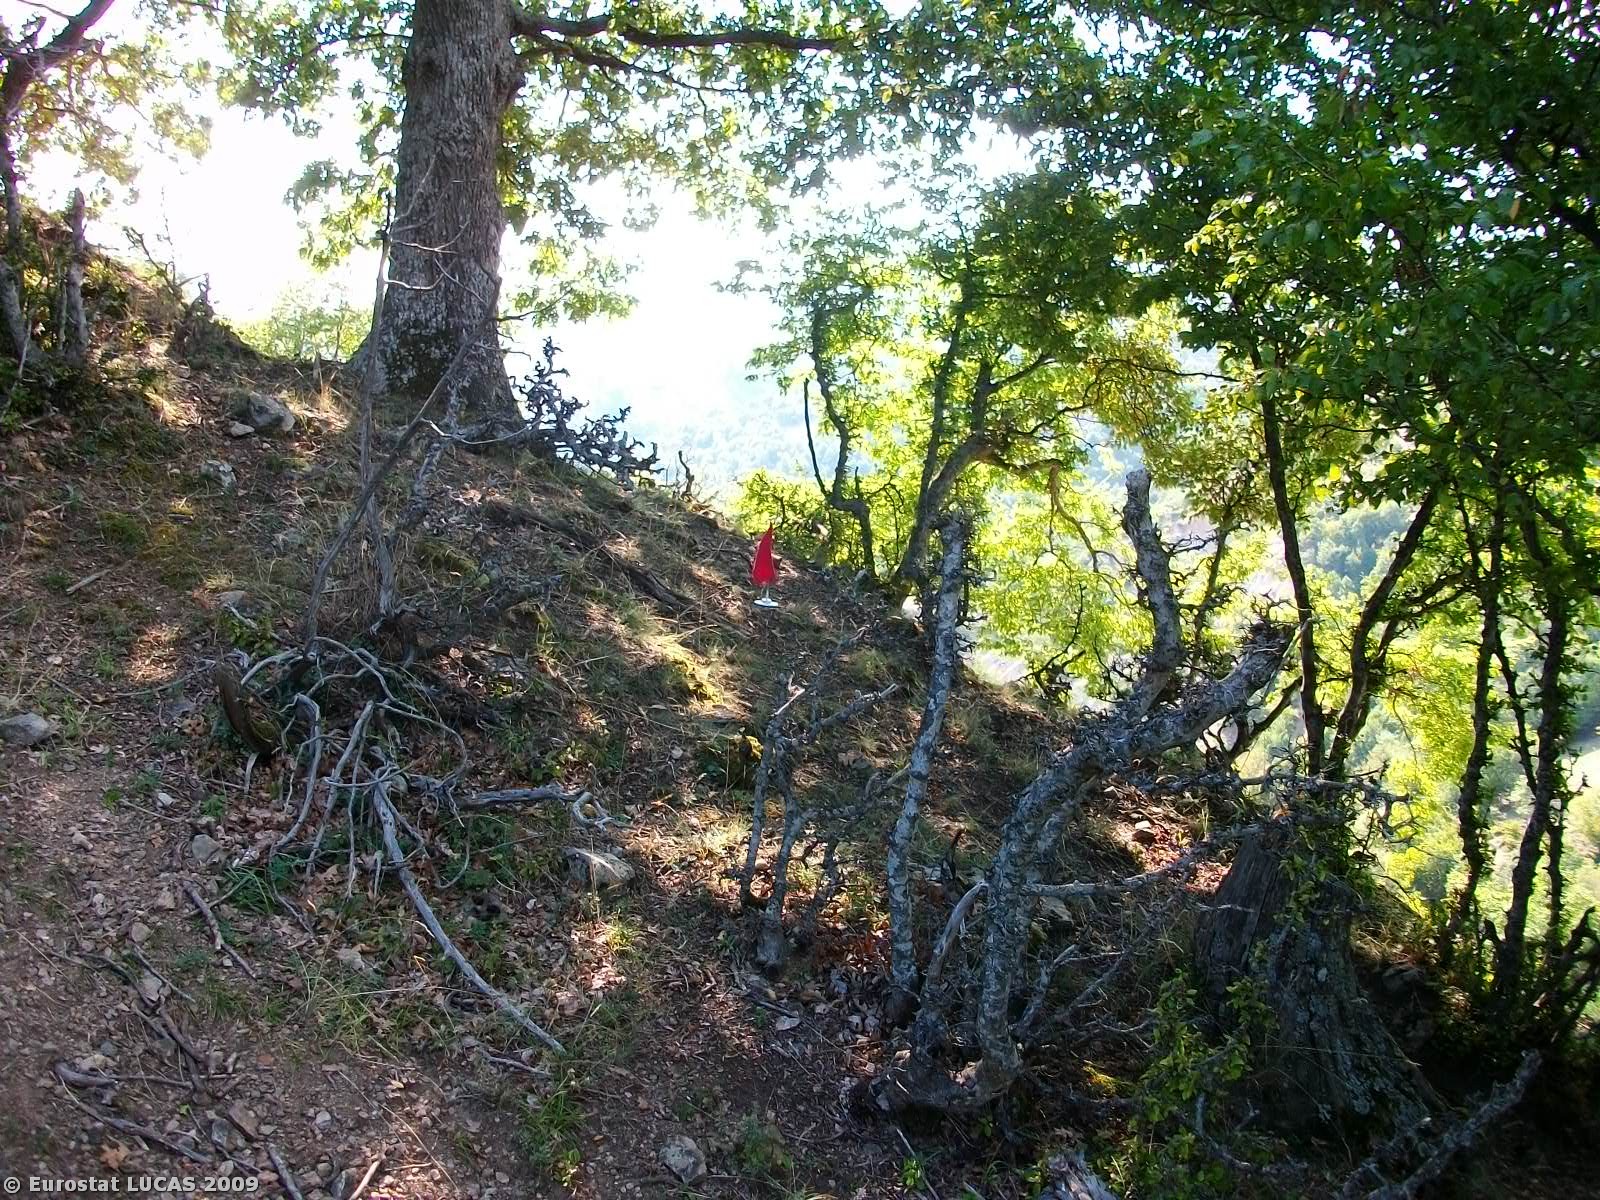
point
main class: Woodland
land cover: Broadleaved woodland
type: thermophilous deciduous forest
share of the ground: > 75 %
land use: Forestry
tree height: > 5 m
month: September
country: GR
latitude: 41.2008
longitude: 23.6044
